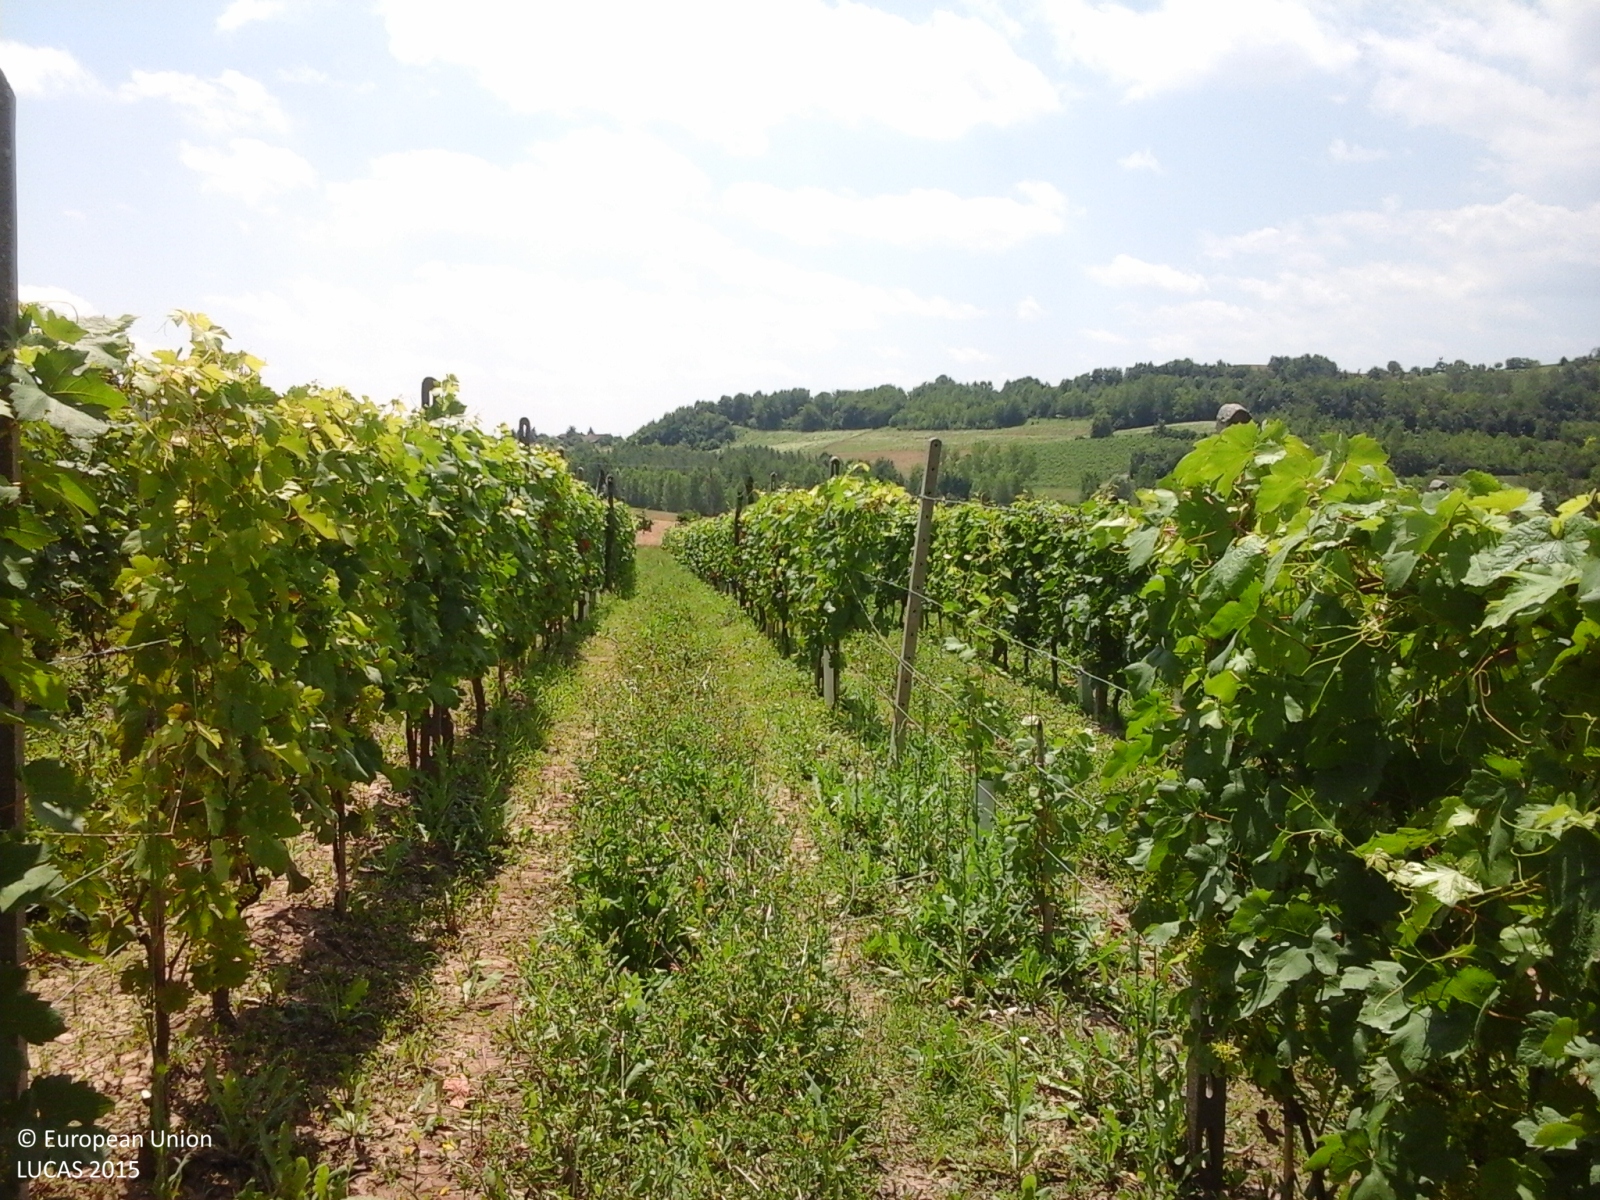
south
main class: Cropland
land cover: Vineyards
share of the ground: > 75 %
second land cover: Grassland without tree/shrub cover
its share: > 75 %
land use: Agriculture (excluding fallow land and kitchen gardens)
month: June
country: IT
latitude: 45.0750
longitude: 8.2376
